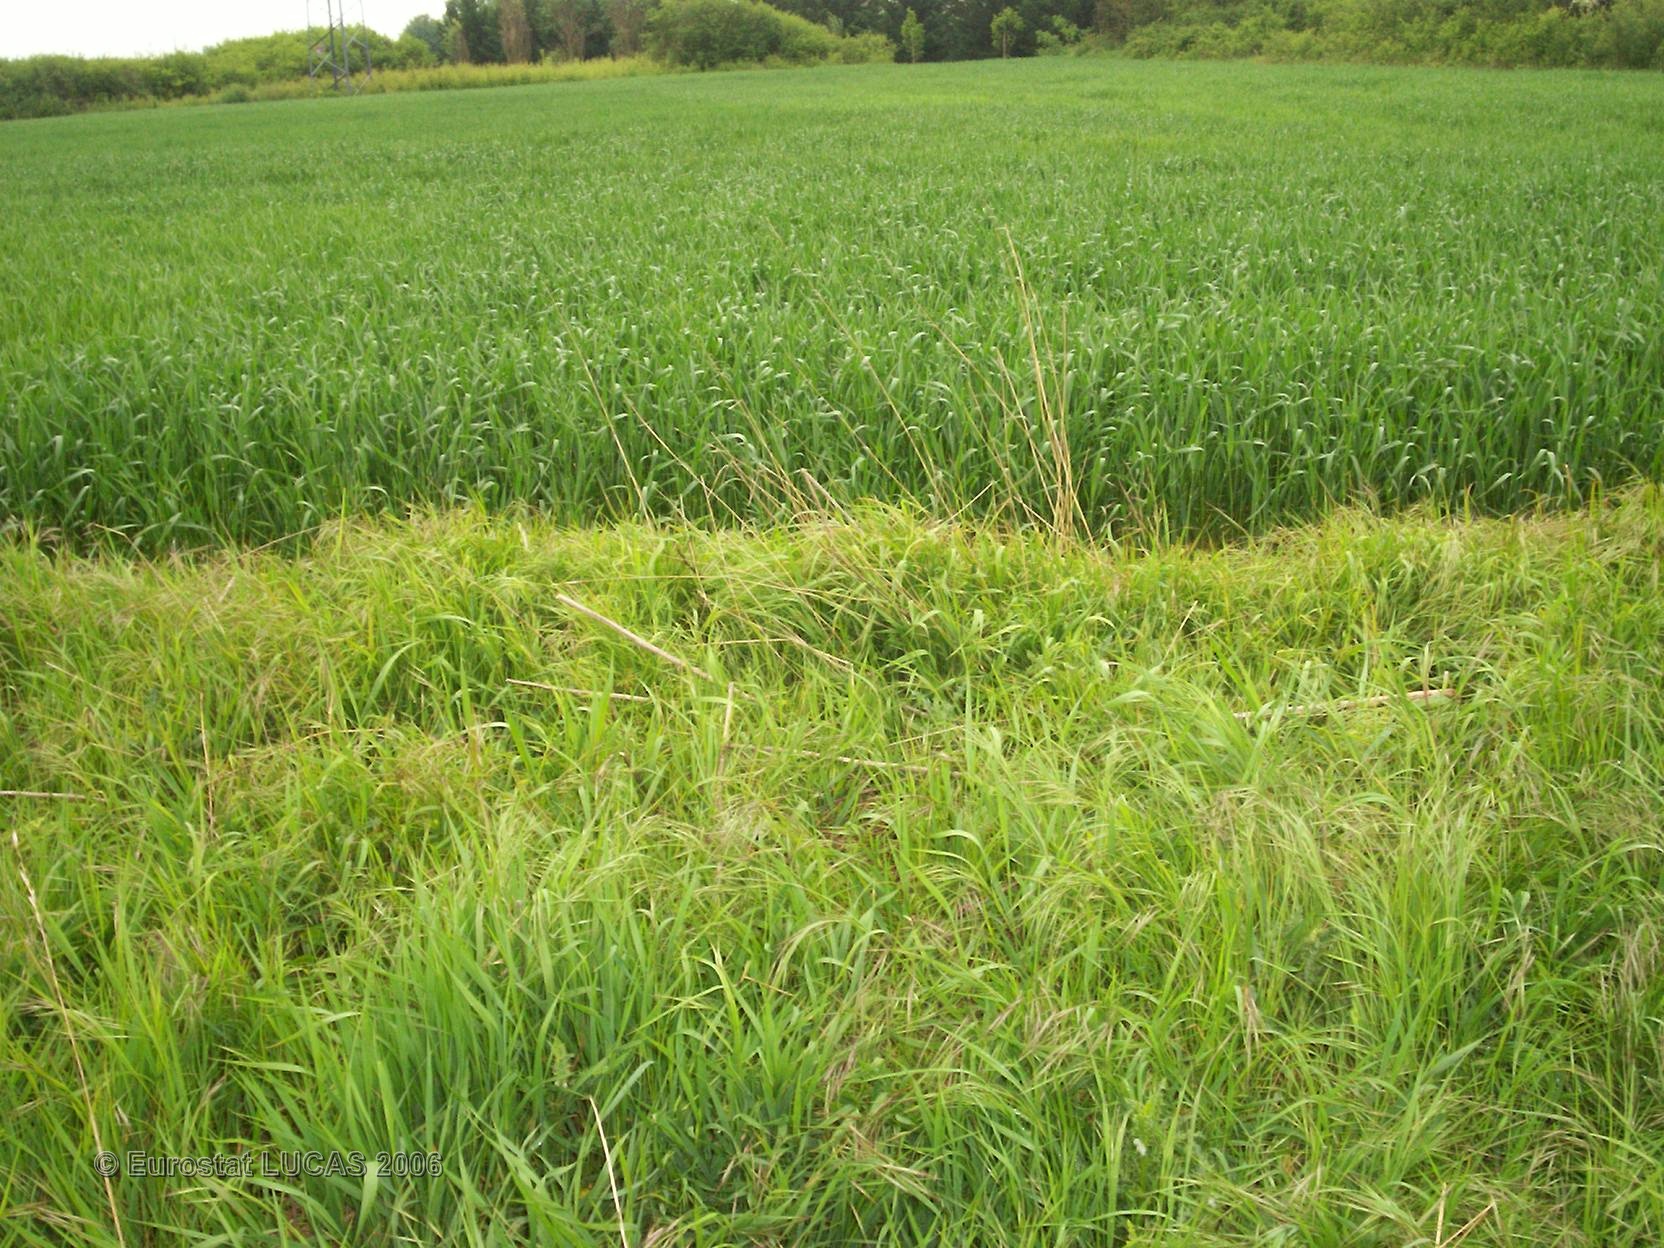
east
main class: Grassland
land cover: Grassland without tree/shrub cover
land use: Agriculture (excluding fallow land and kitchen gardens)
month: May
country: FR
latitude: 46.5883
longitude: 0.3885
